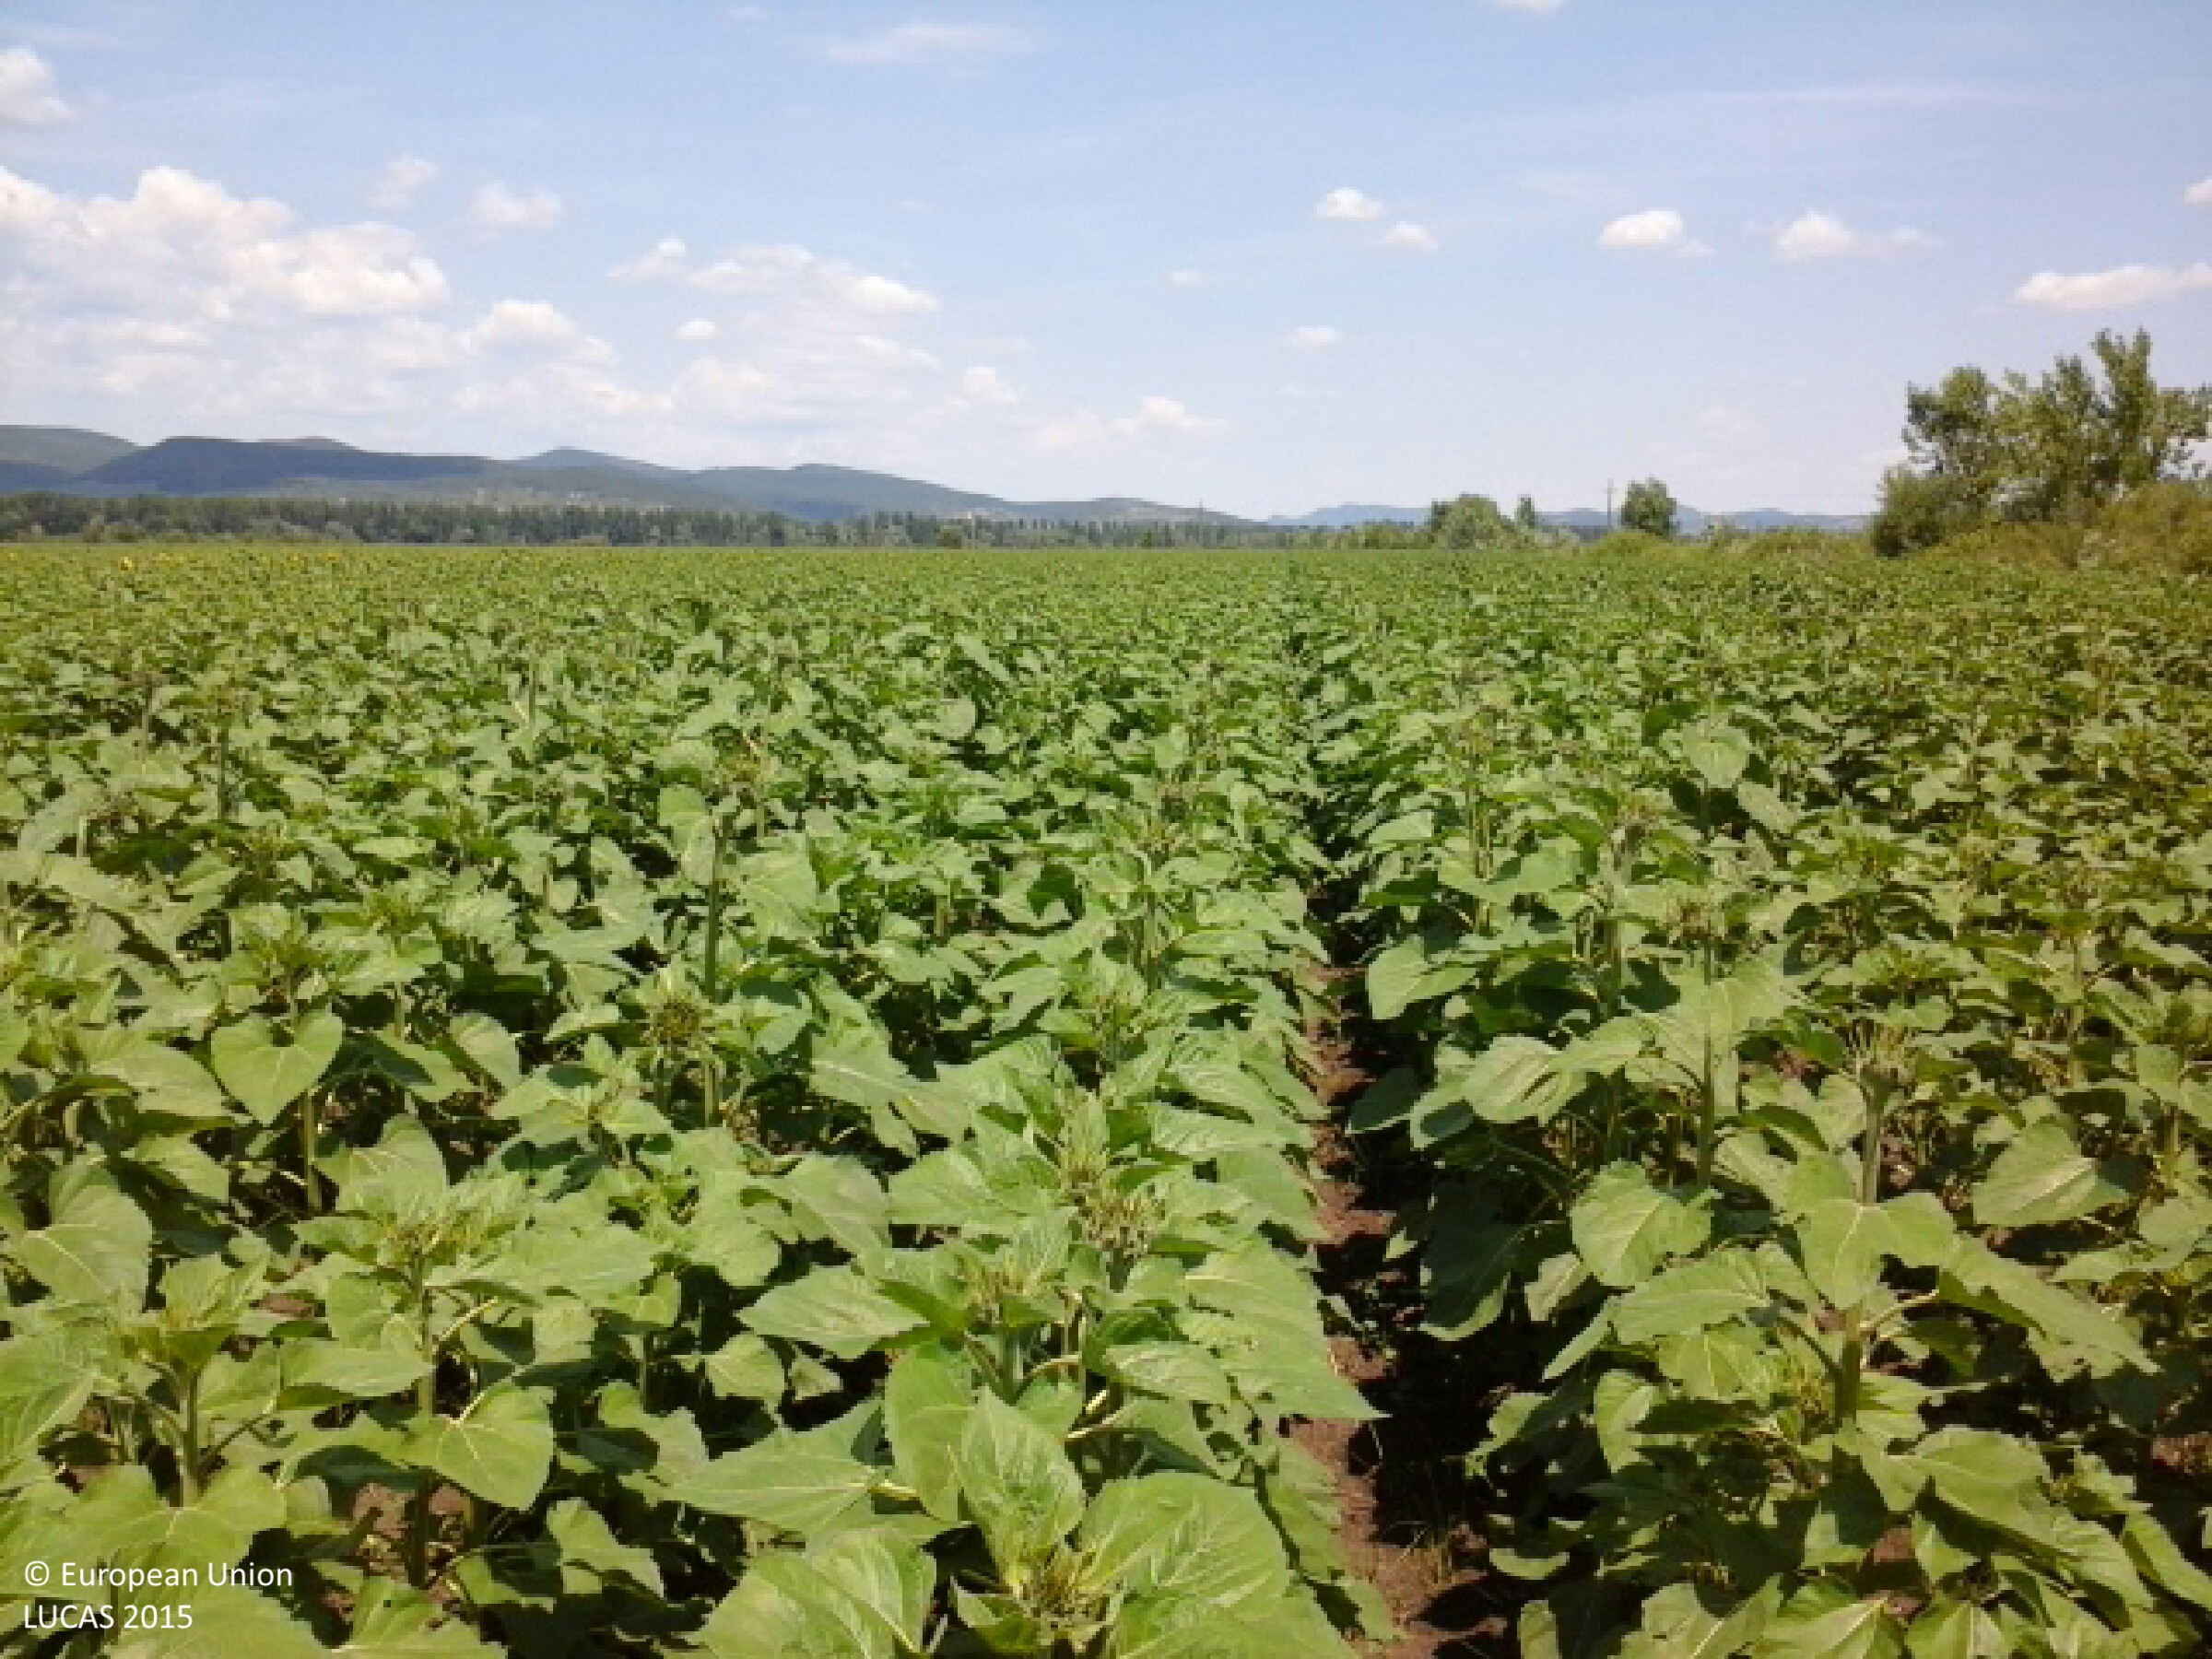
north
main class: Cropland
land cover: Sunflower
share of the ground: > 75 %
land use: Agriculture (excluding fallow land and kitchen gardens)
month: July
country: HU
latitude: 48.2547
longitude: 21.5083
